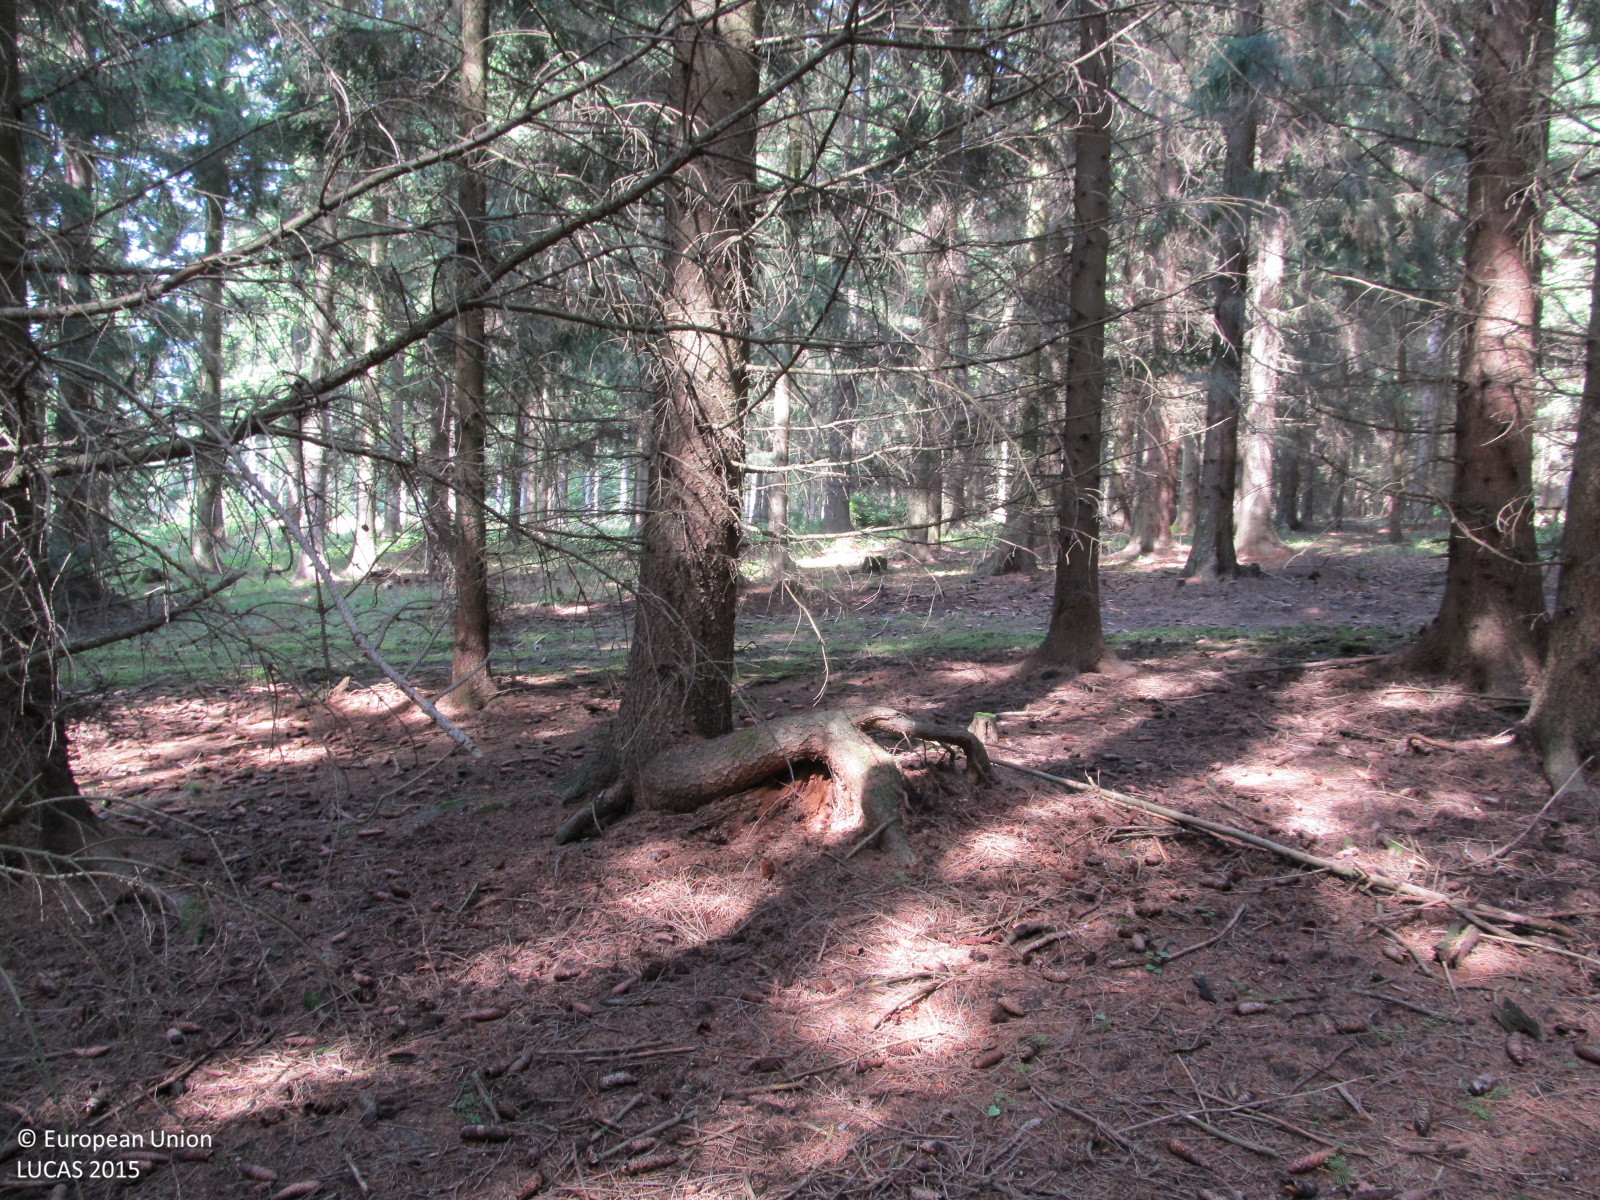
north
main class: Woodland
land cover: Spruce dominated coniferous woodland
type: hemiboreal forest and nemoral coniferous forest and mixed broadleaved-coniferous forest
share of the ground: > 75 %
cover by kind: coniferous forest trees 80 %, unconsolidated bare surface 20 %
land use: Forestry
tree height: > 5 m
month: August
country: AT
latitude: 48.7337
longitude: 15.5369
